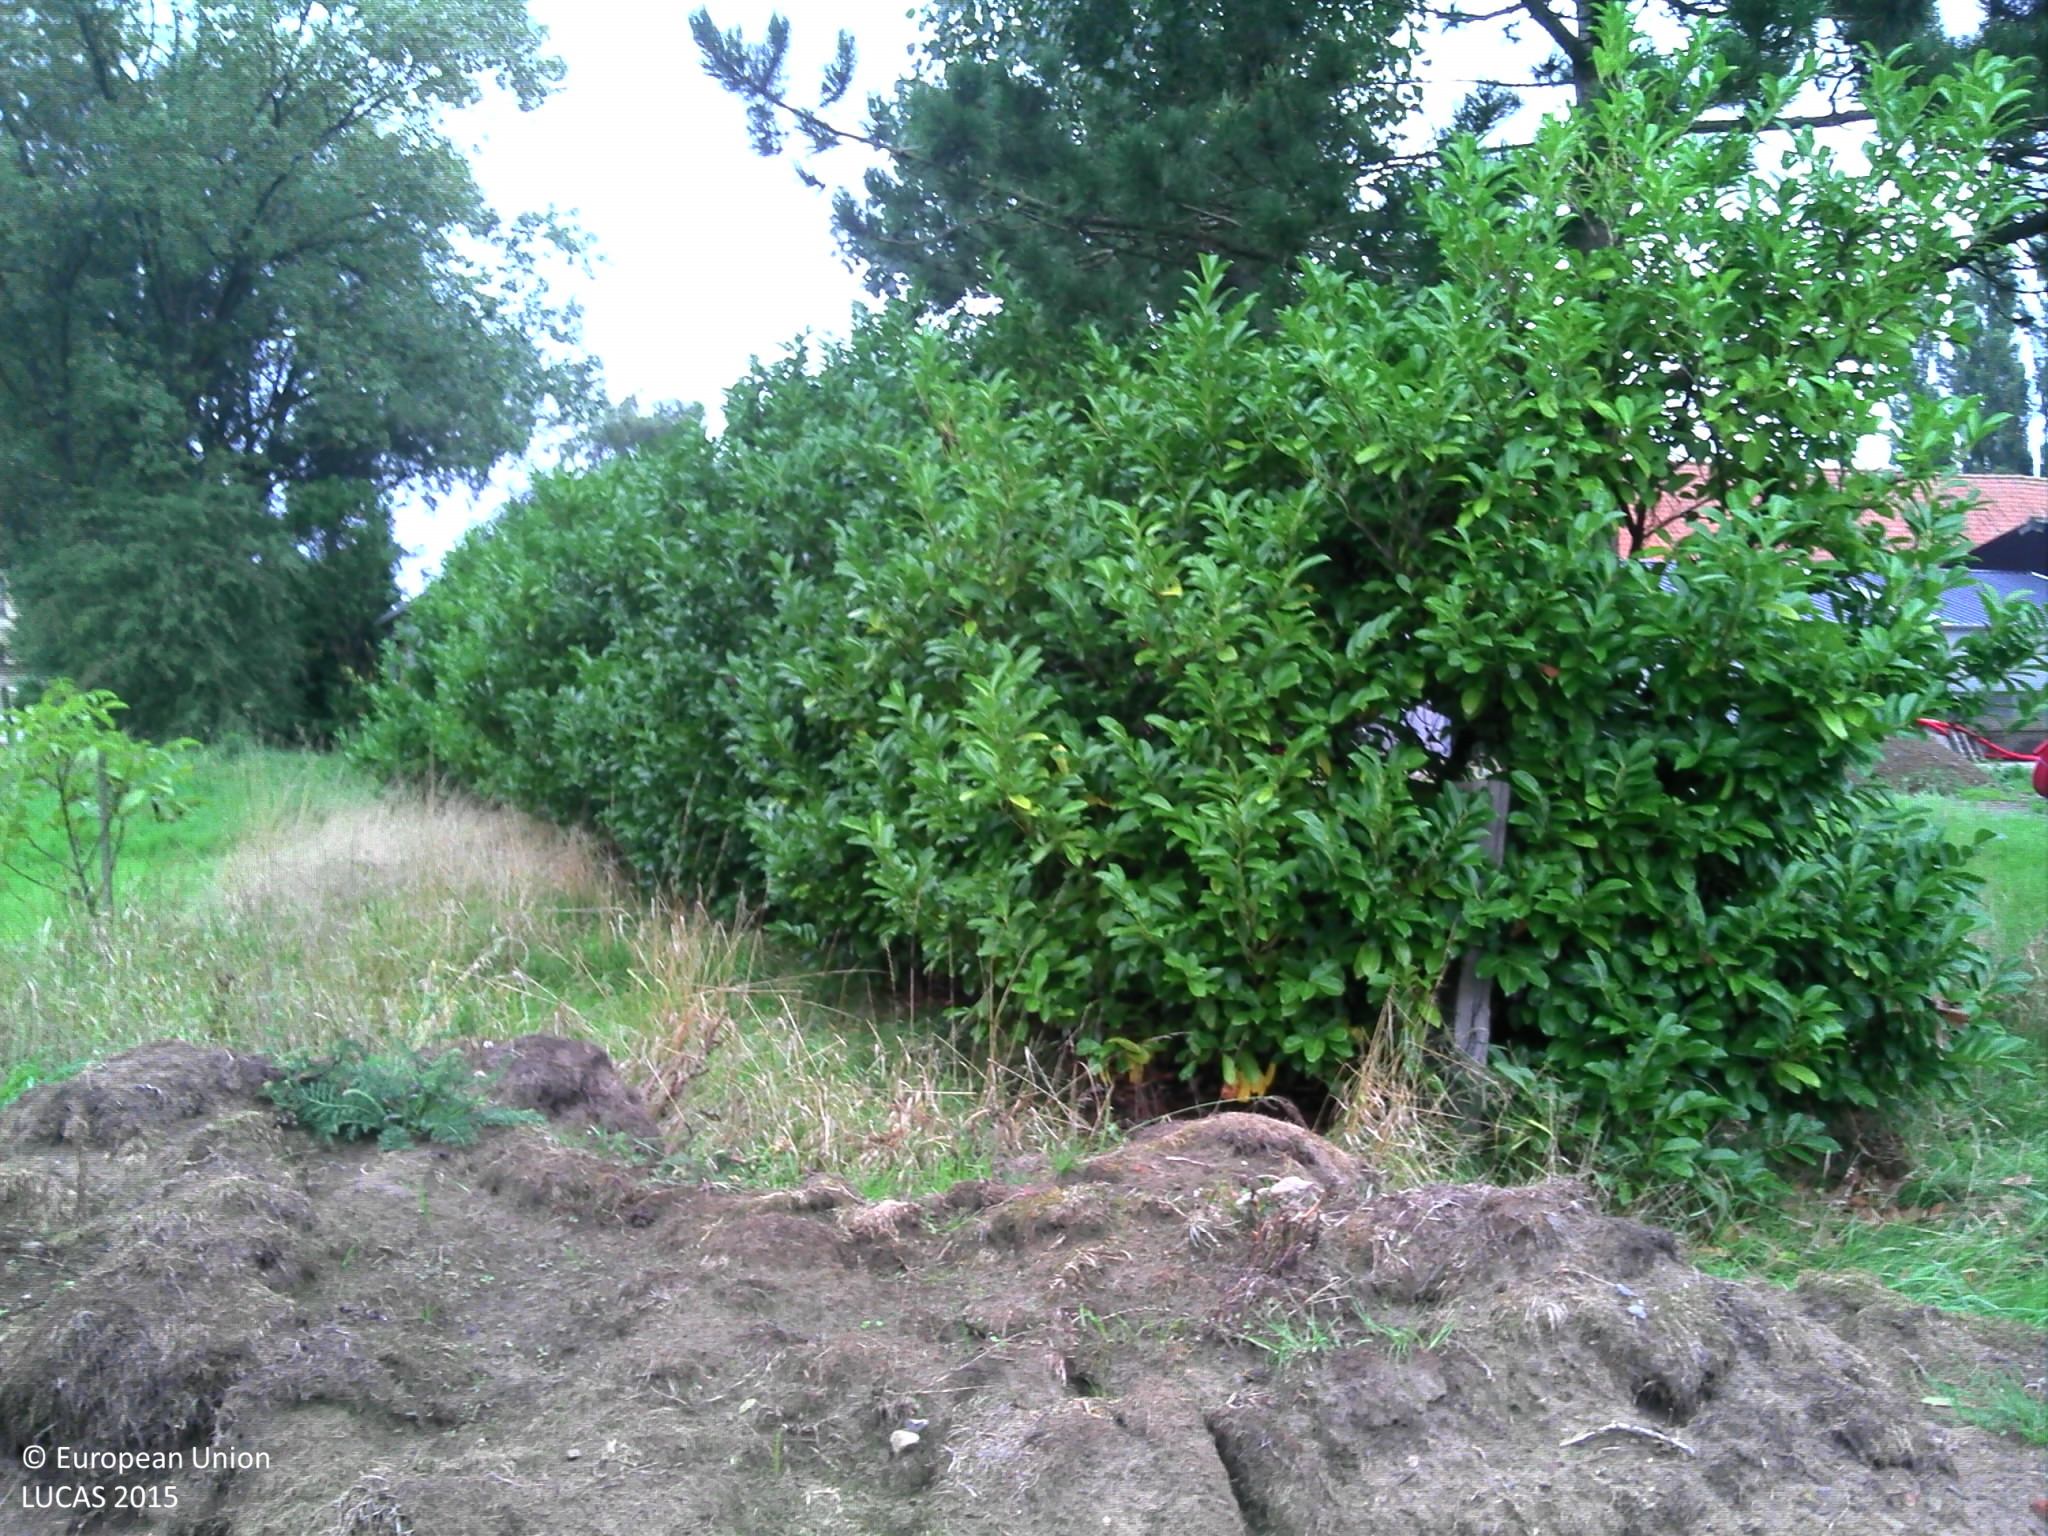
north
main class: Grassland
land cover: Grassland without tree/shrub cover
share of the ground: > 75 %
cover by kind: herbaceous plants 100 %
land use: Agriculture (excluding fallow land and kitchen gardens)
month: September
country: BE
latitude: 50.9866
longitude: 3.4246
